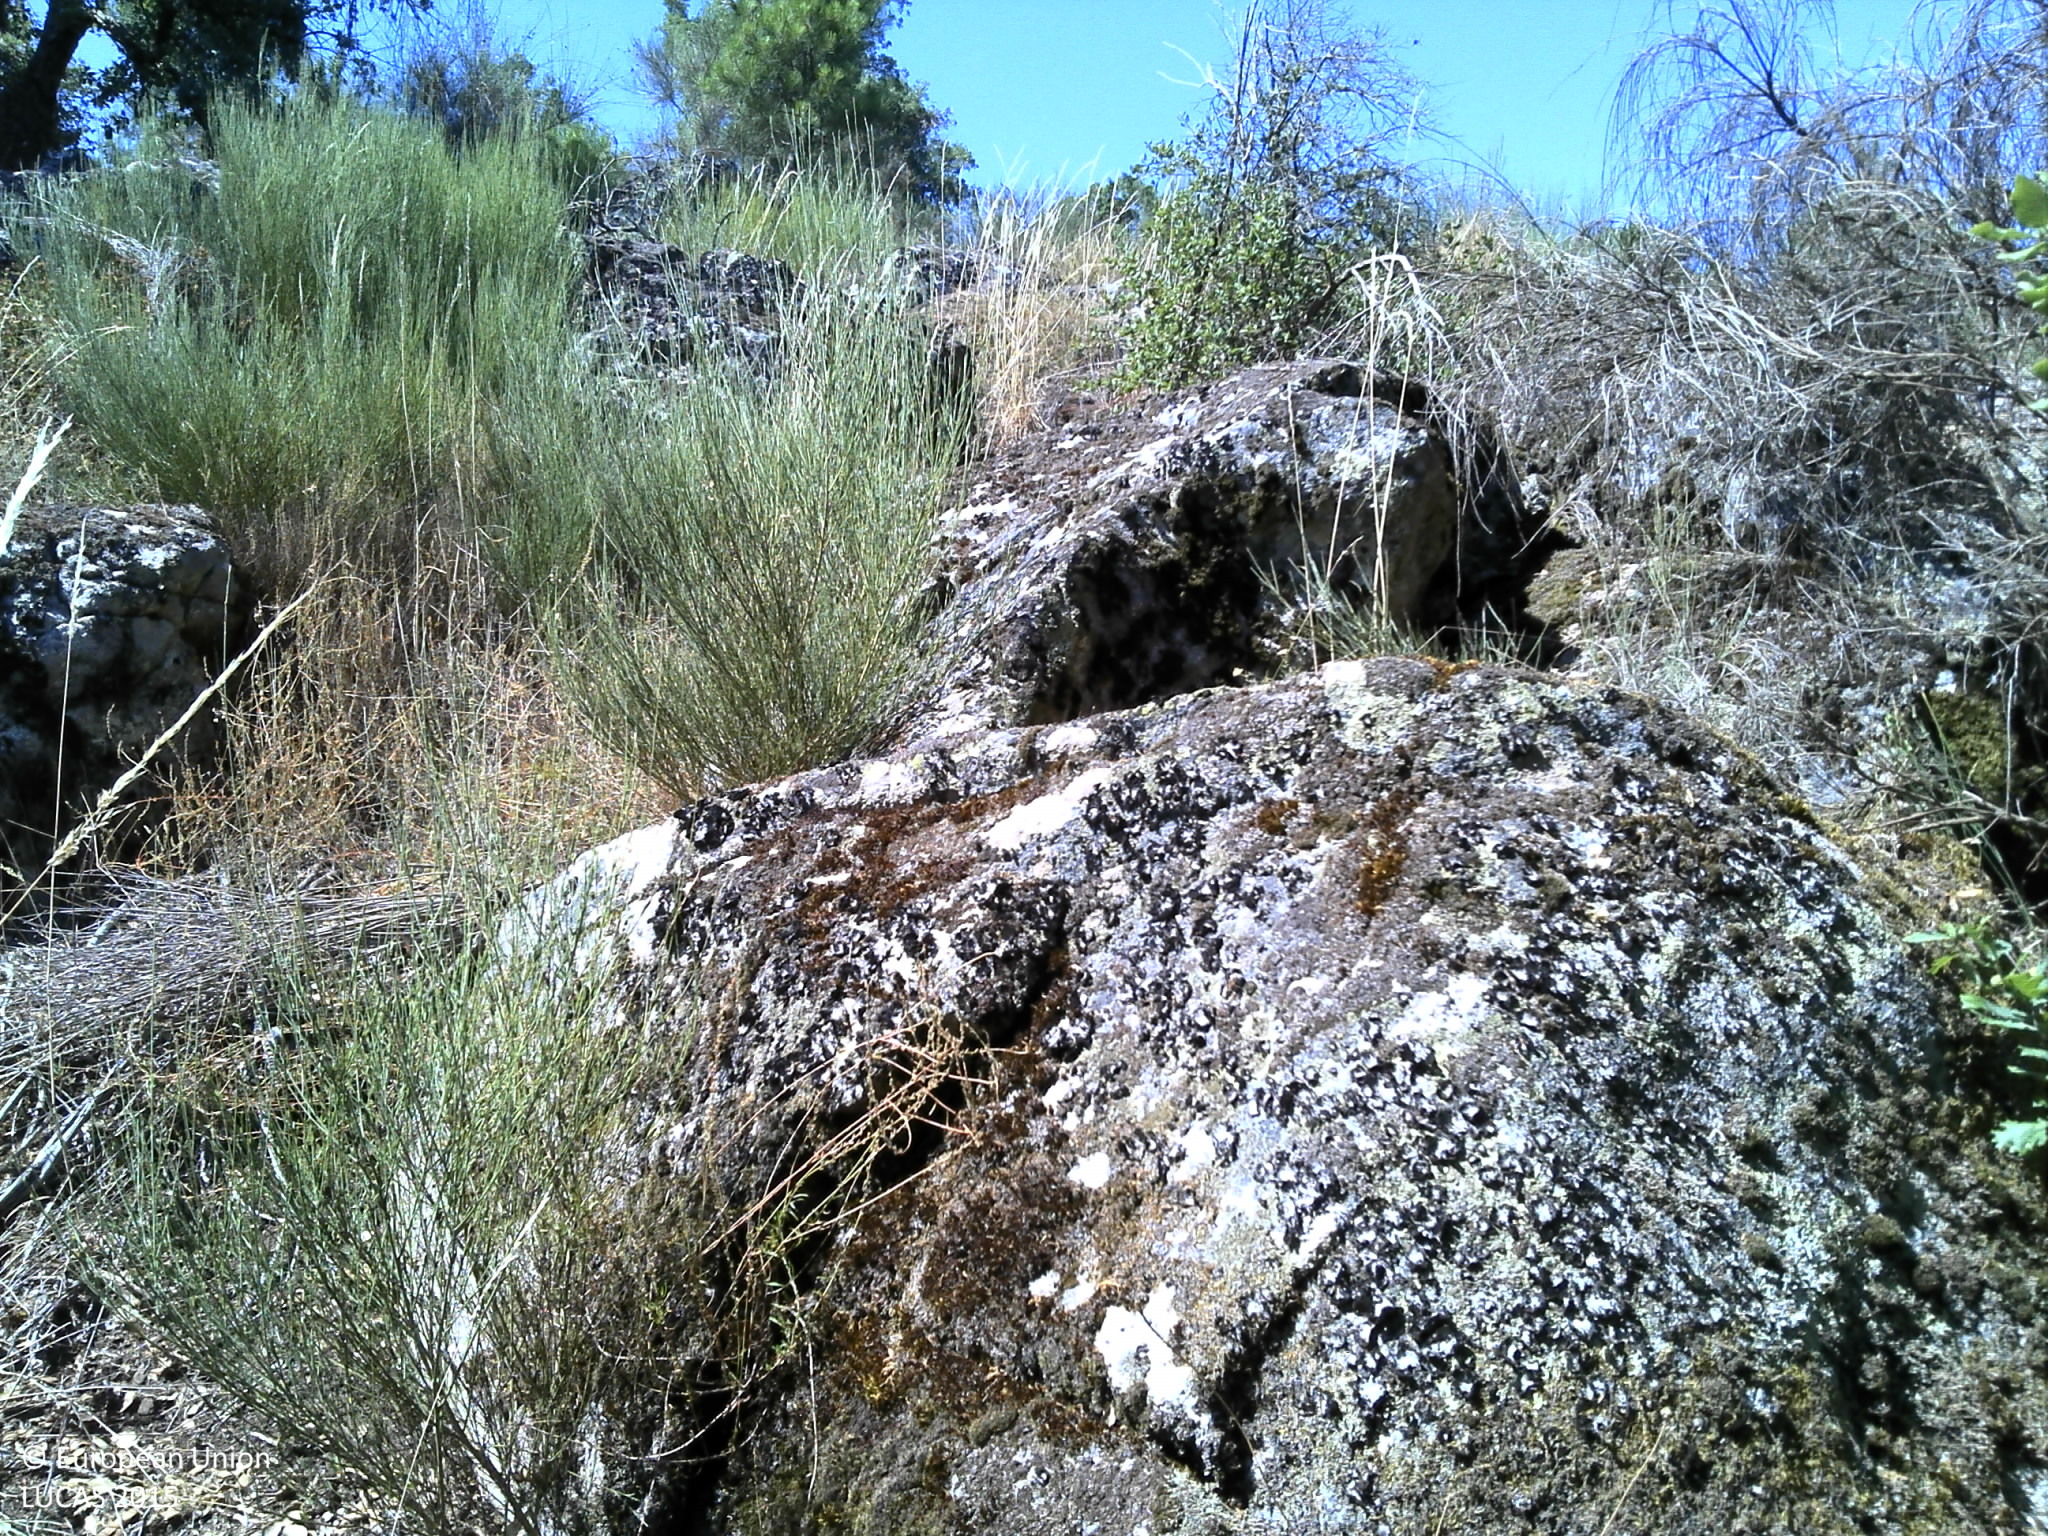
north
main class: Woodland
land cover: Broadleaved woodland
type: broadleaved evergreen forest
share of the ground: 10 - 25 %
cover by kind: shrubs 50 %, broadleaved forest trees 25 %, unconsolidated bare surface 25 %
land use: Forestry
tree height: > 5 m
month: July
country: PT
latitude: 39.9091
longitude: -8.1435
